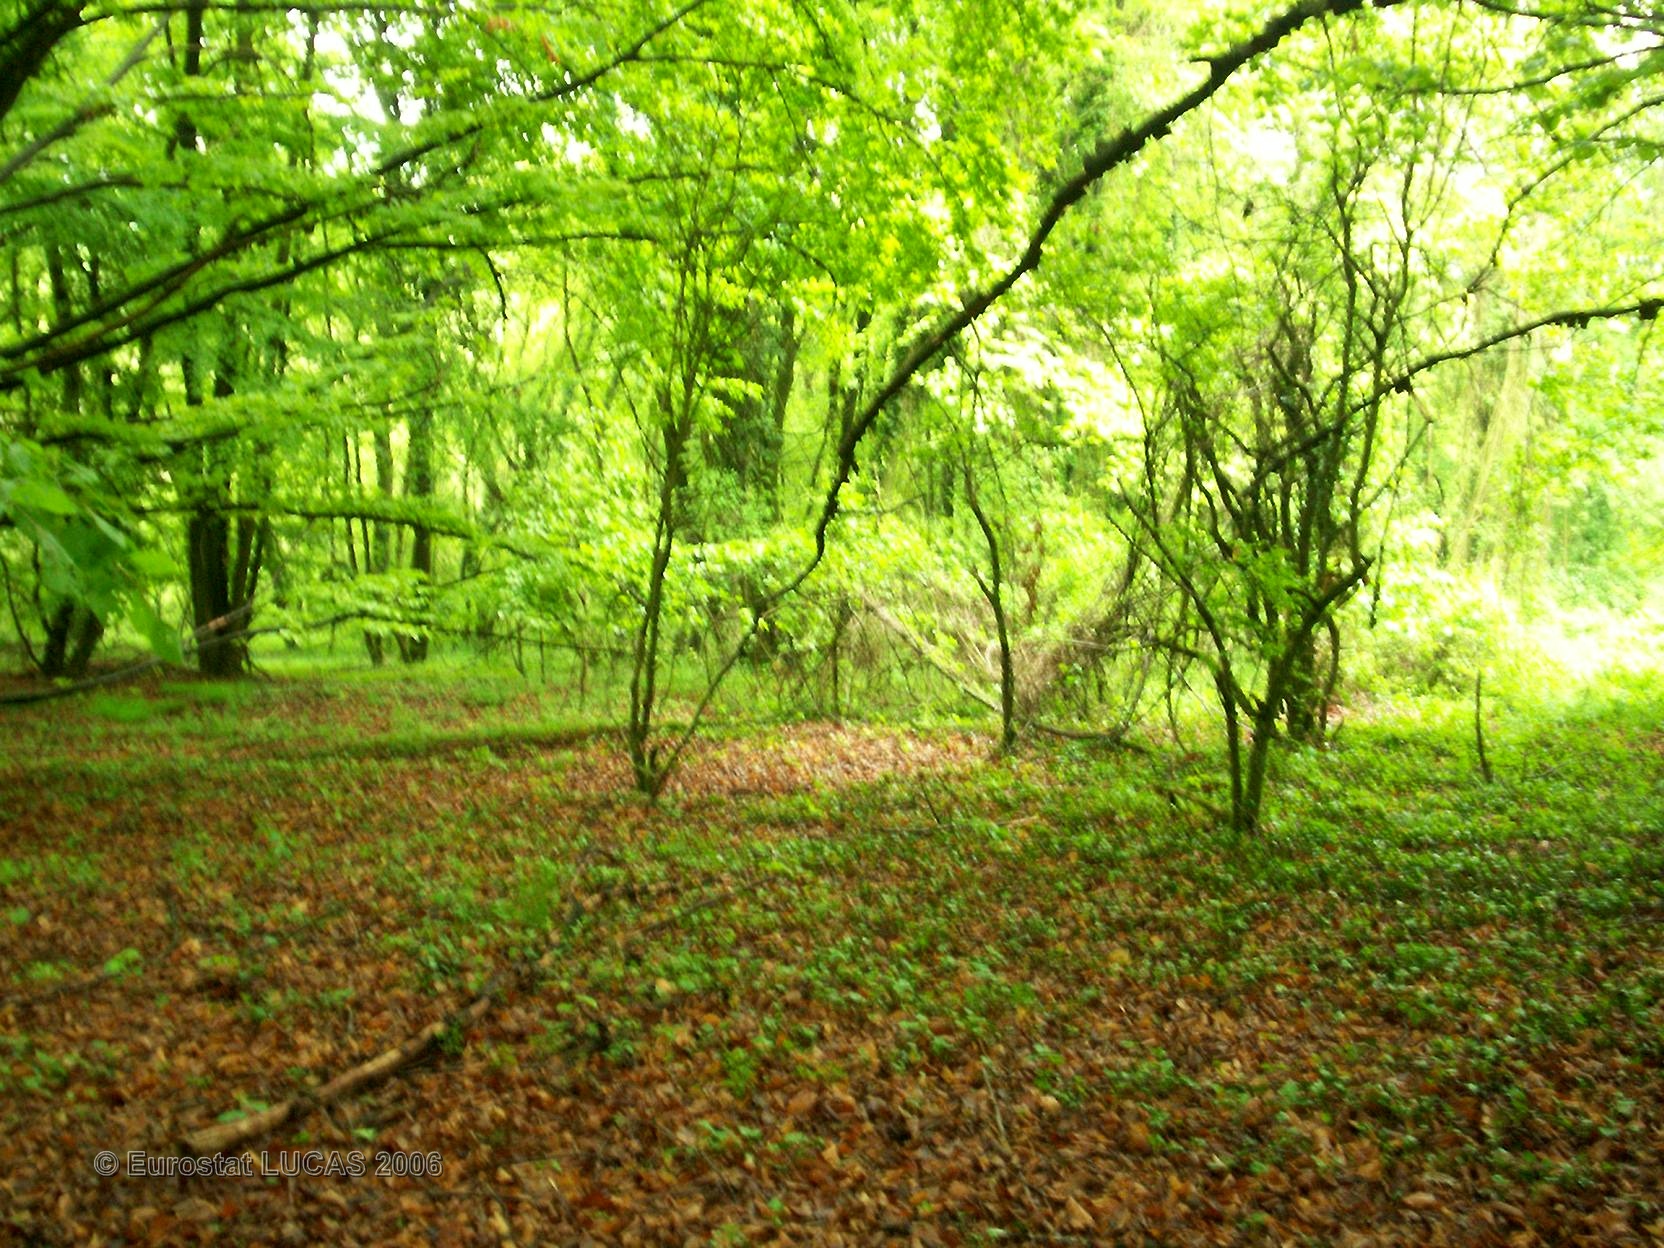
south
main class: Woodland
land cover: Broadleaved forest
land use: Forestry
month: May
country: FR
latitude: 49.3176
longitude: 6.4093
